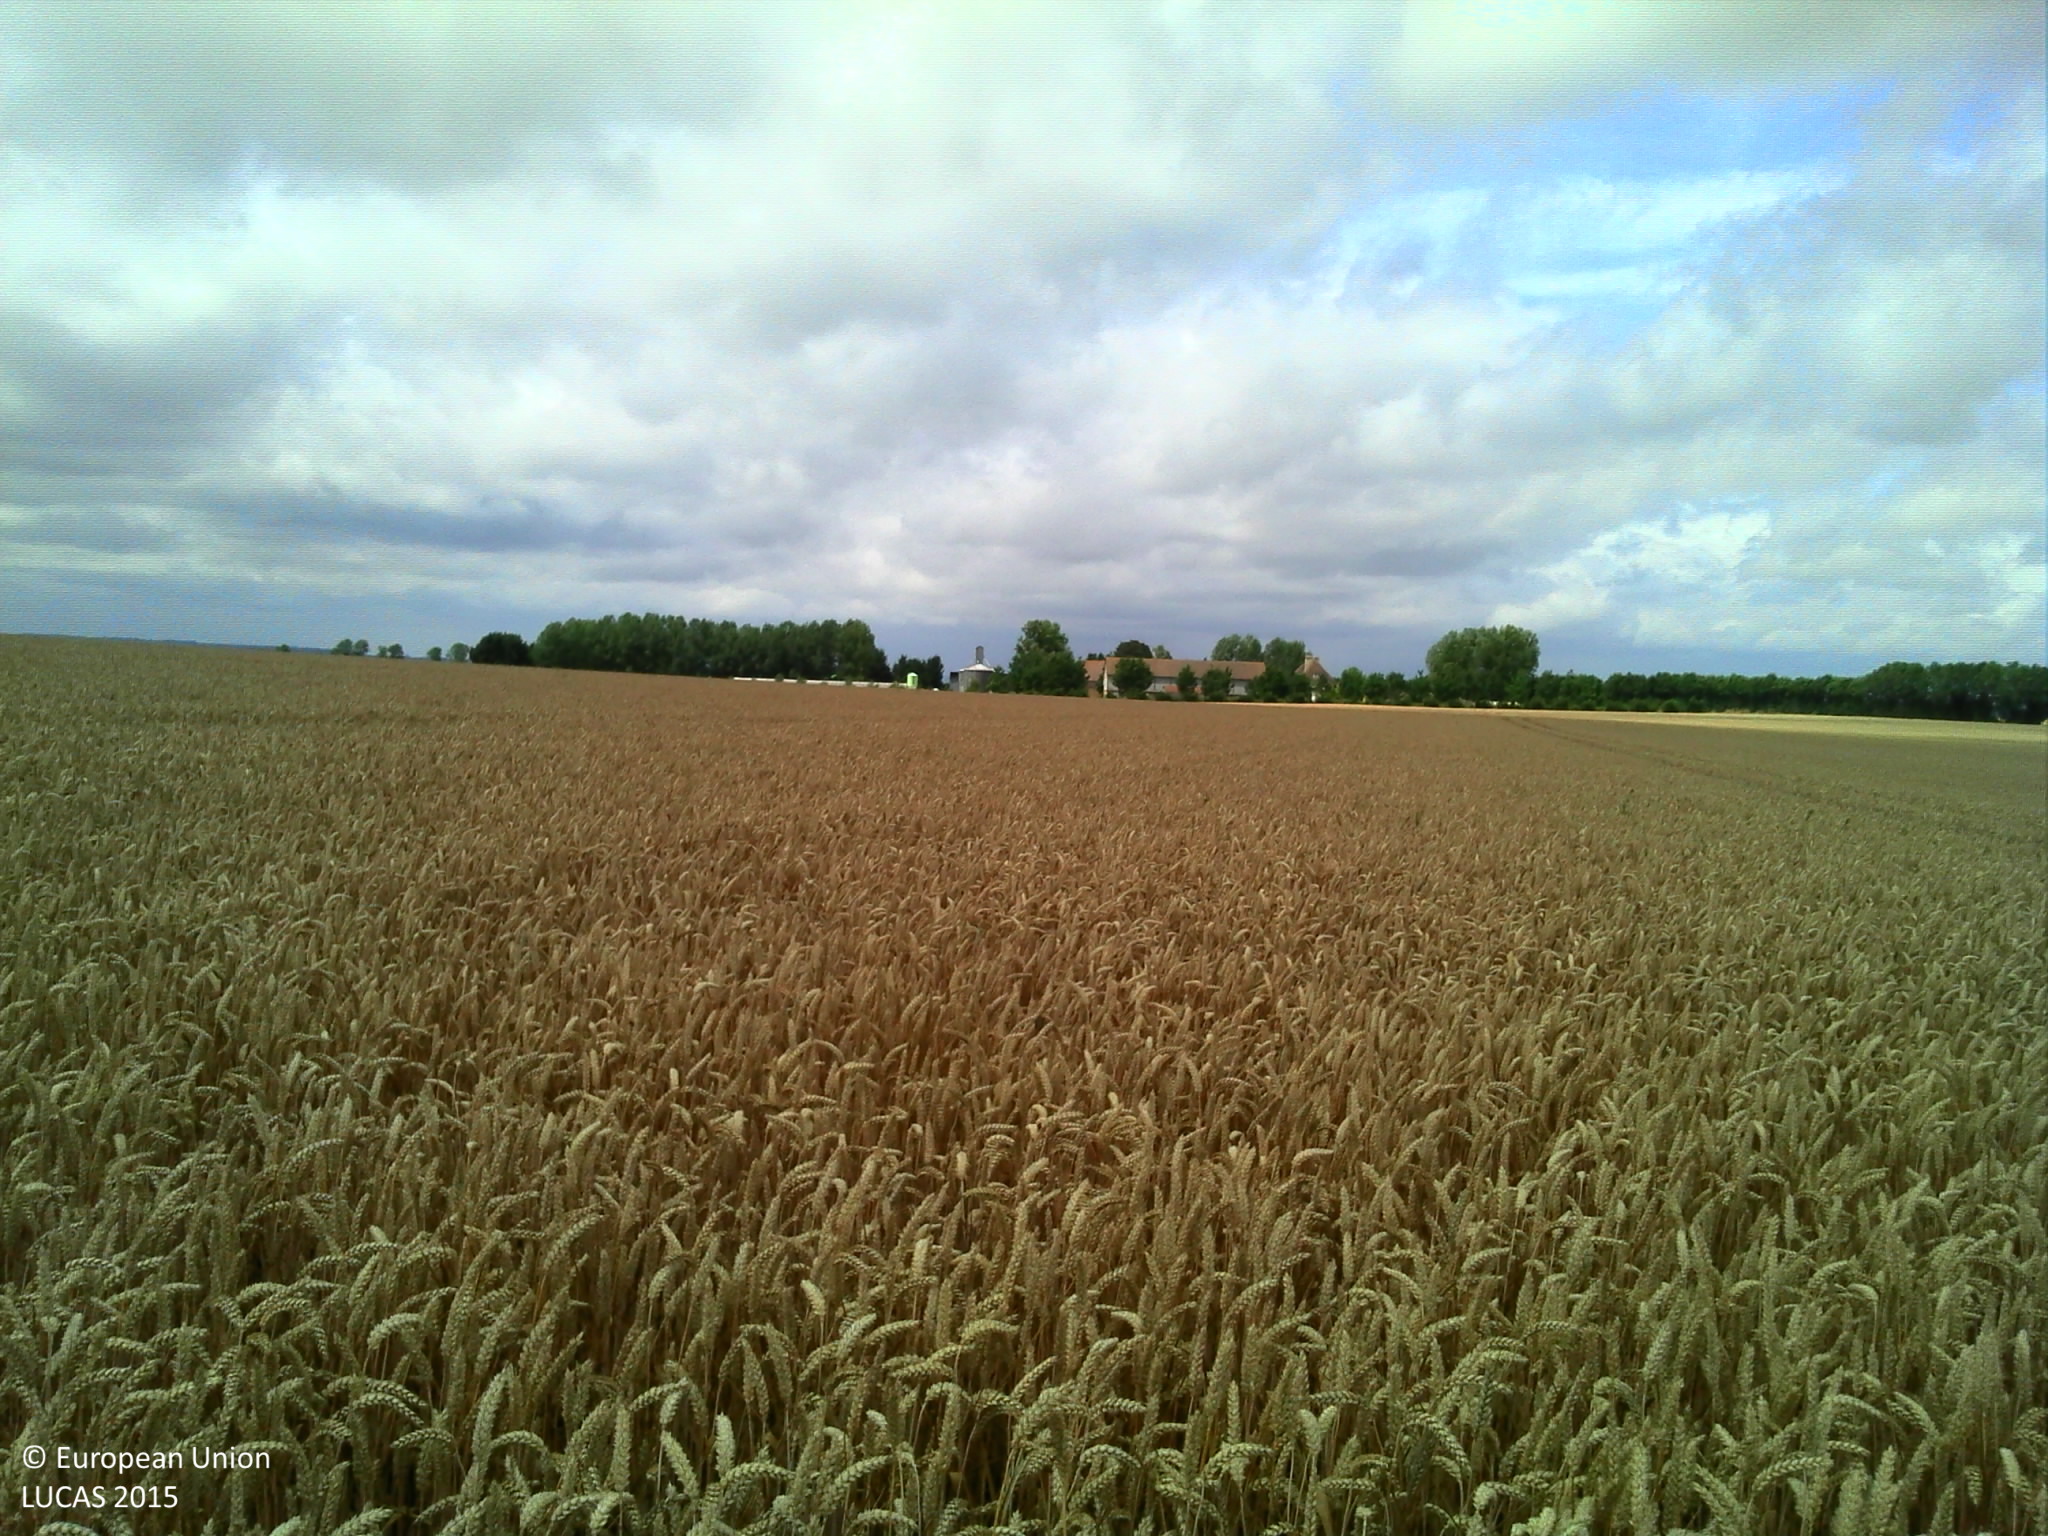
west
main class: Cropland
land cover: Common wheat
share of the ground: > 75 %
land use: Agriculture (excluding fallow land and kitchen gardens)
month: July
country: FR
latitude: 48.9762
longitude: -0.2665
